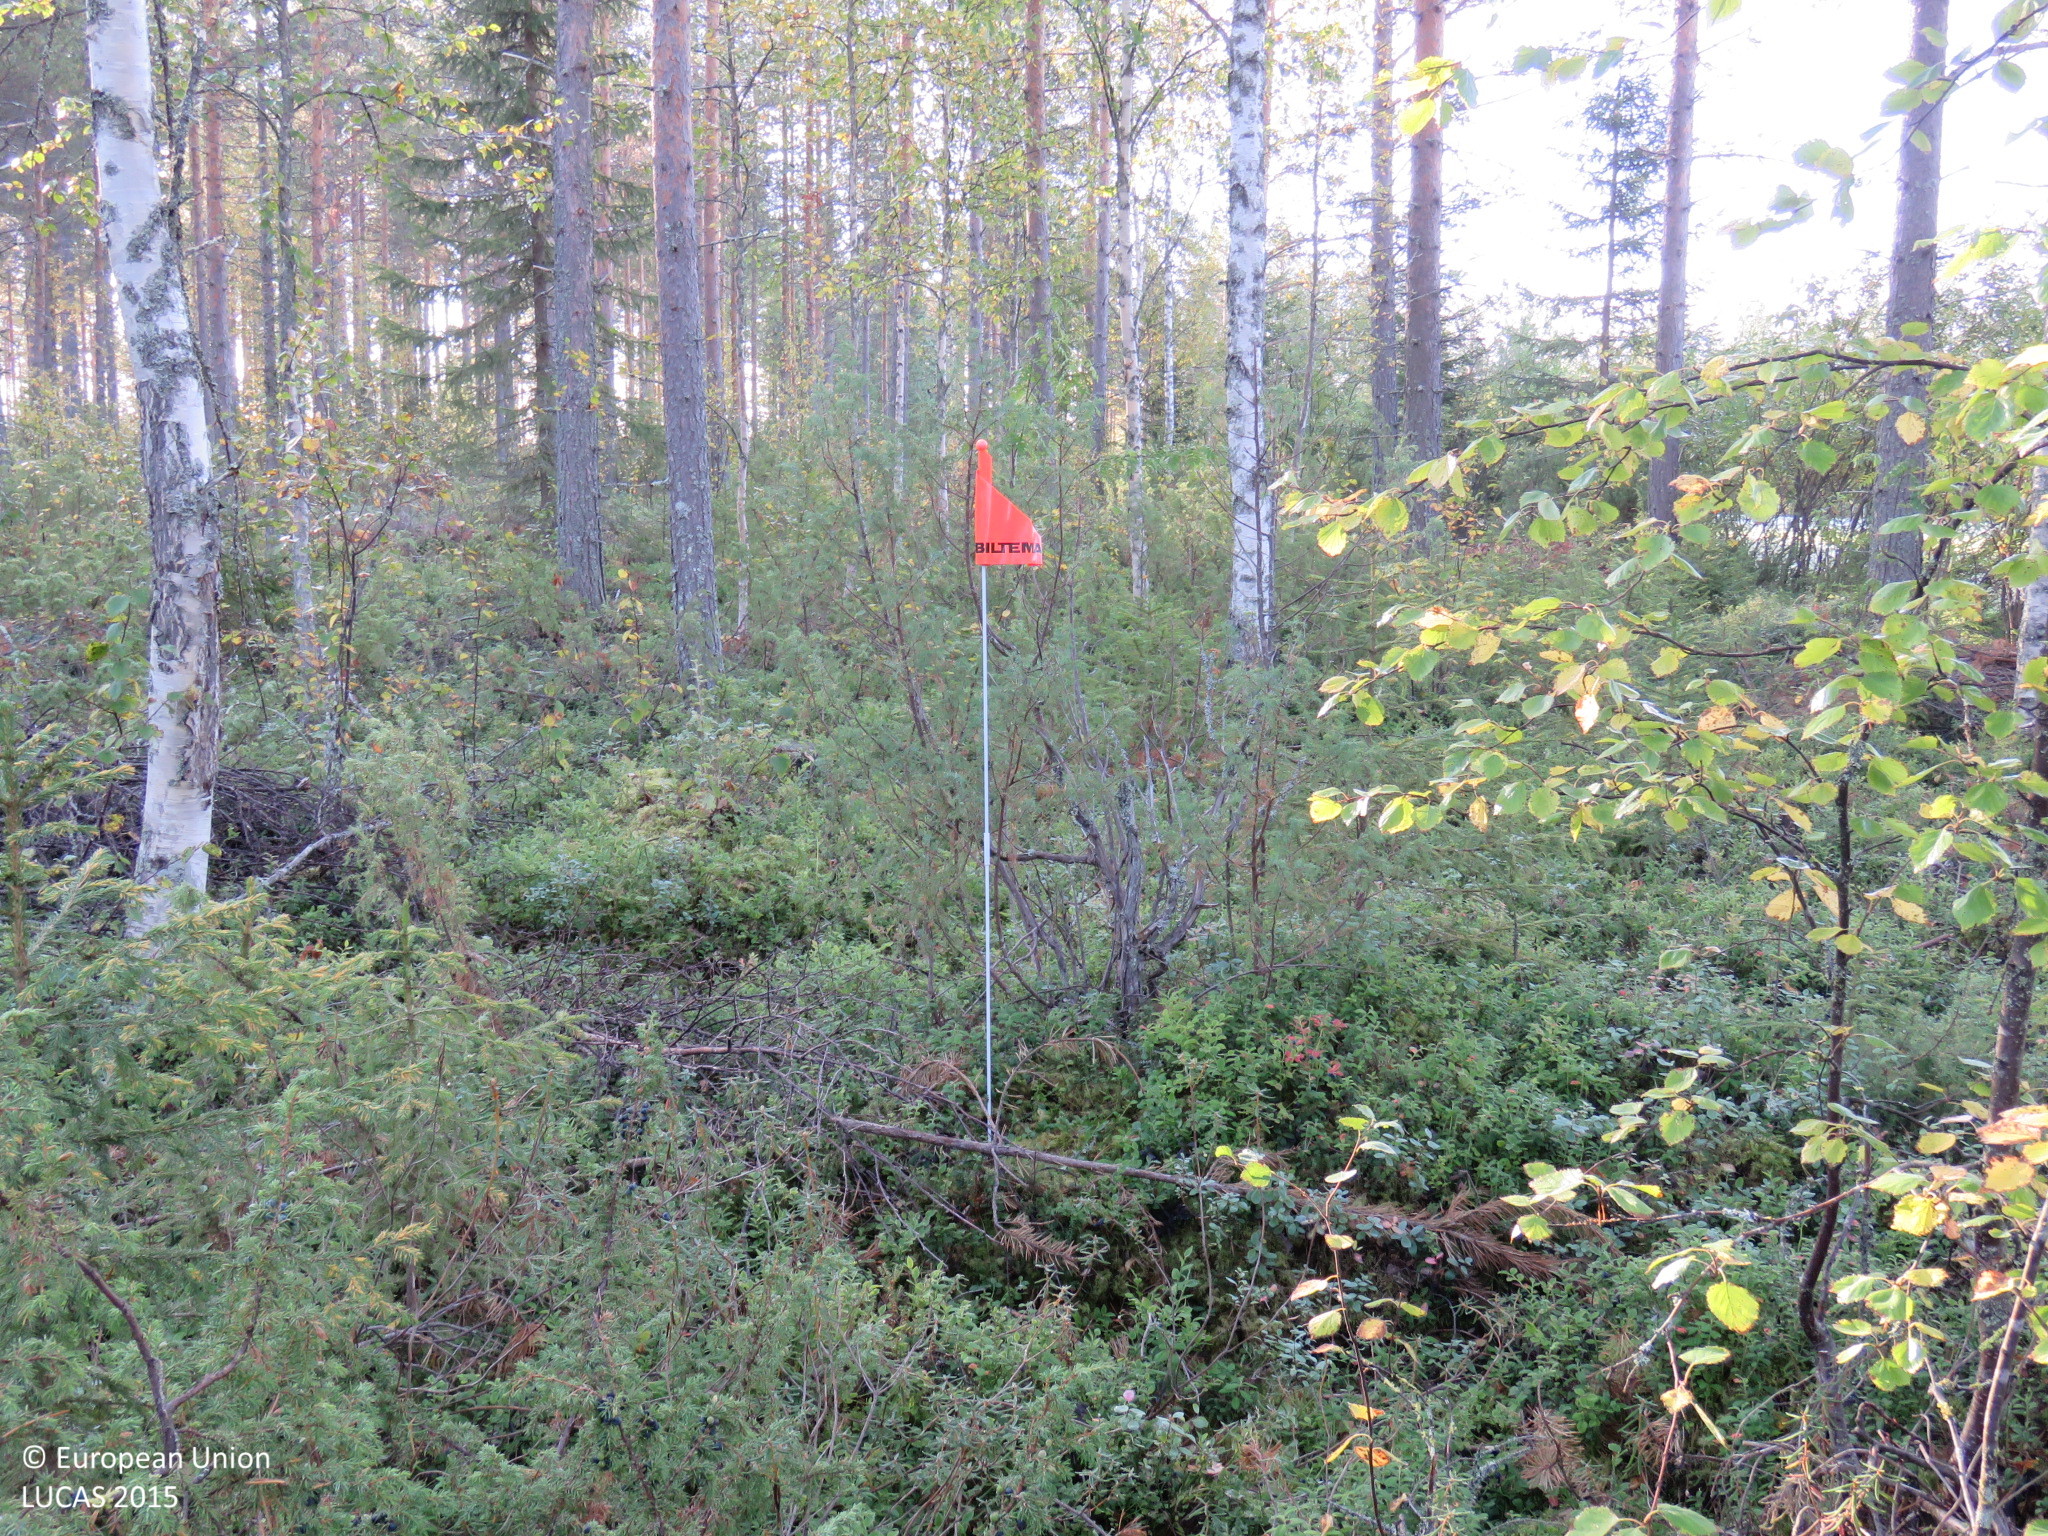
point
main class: Woodland
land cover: Pine dominated mixed woodland
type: boreal forest
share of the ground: > 75 %
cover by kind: coniferous forest trees 45 %, broadleaved forest trees 35 %, shrubs 20 %
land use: Forestry
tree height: > 5 m
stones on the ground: < 10 %
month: September
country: FI
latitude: 65.4745
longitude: 27.5546
